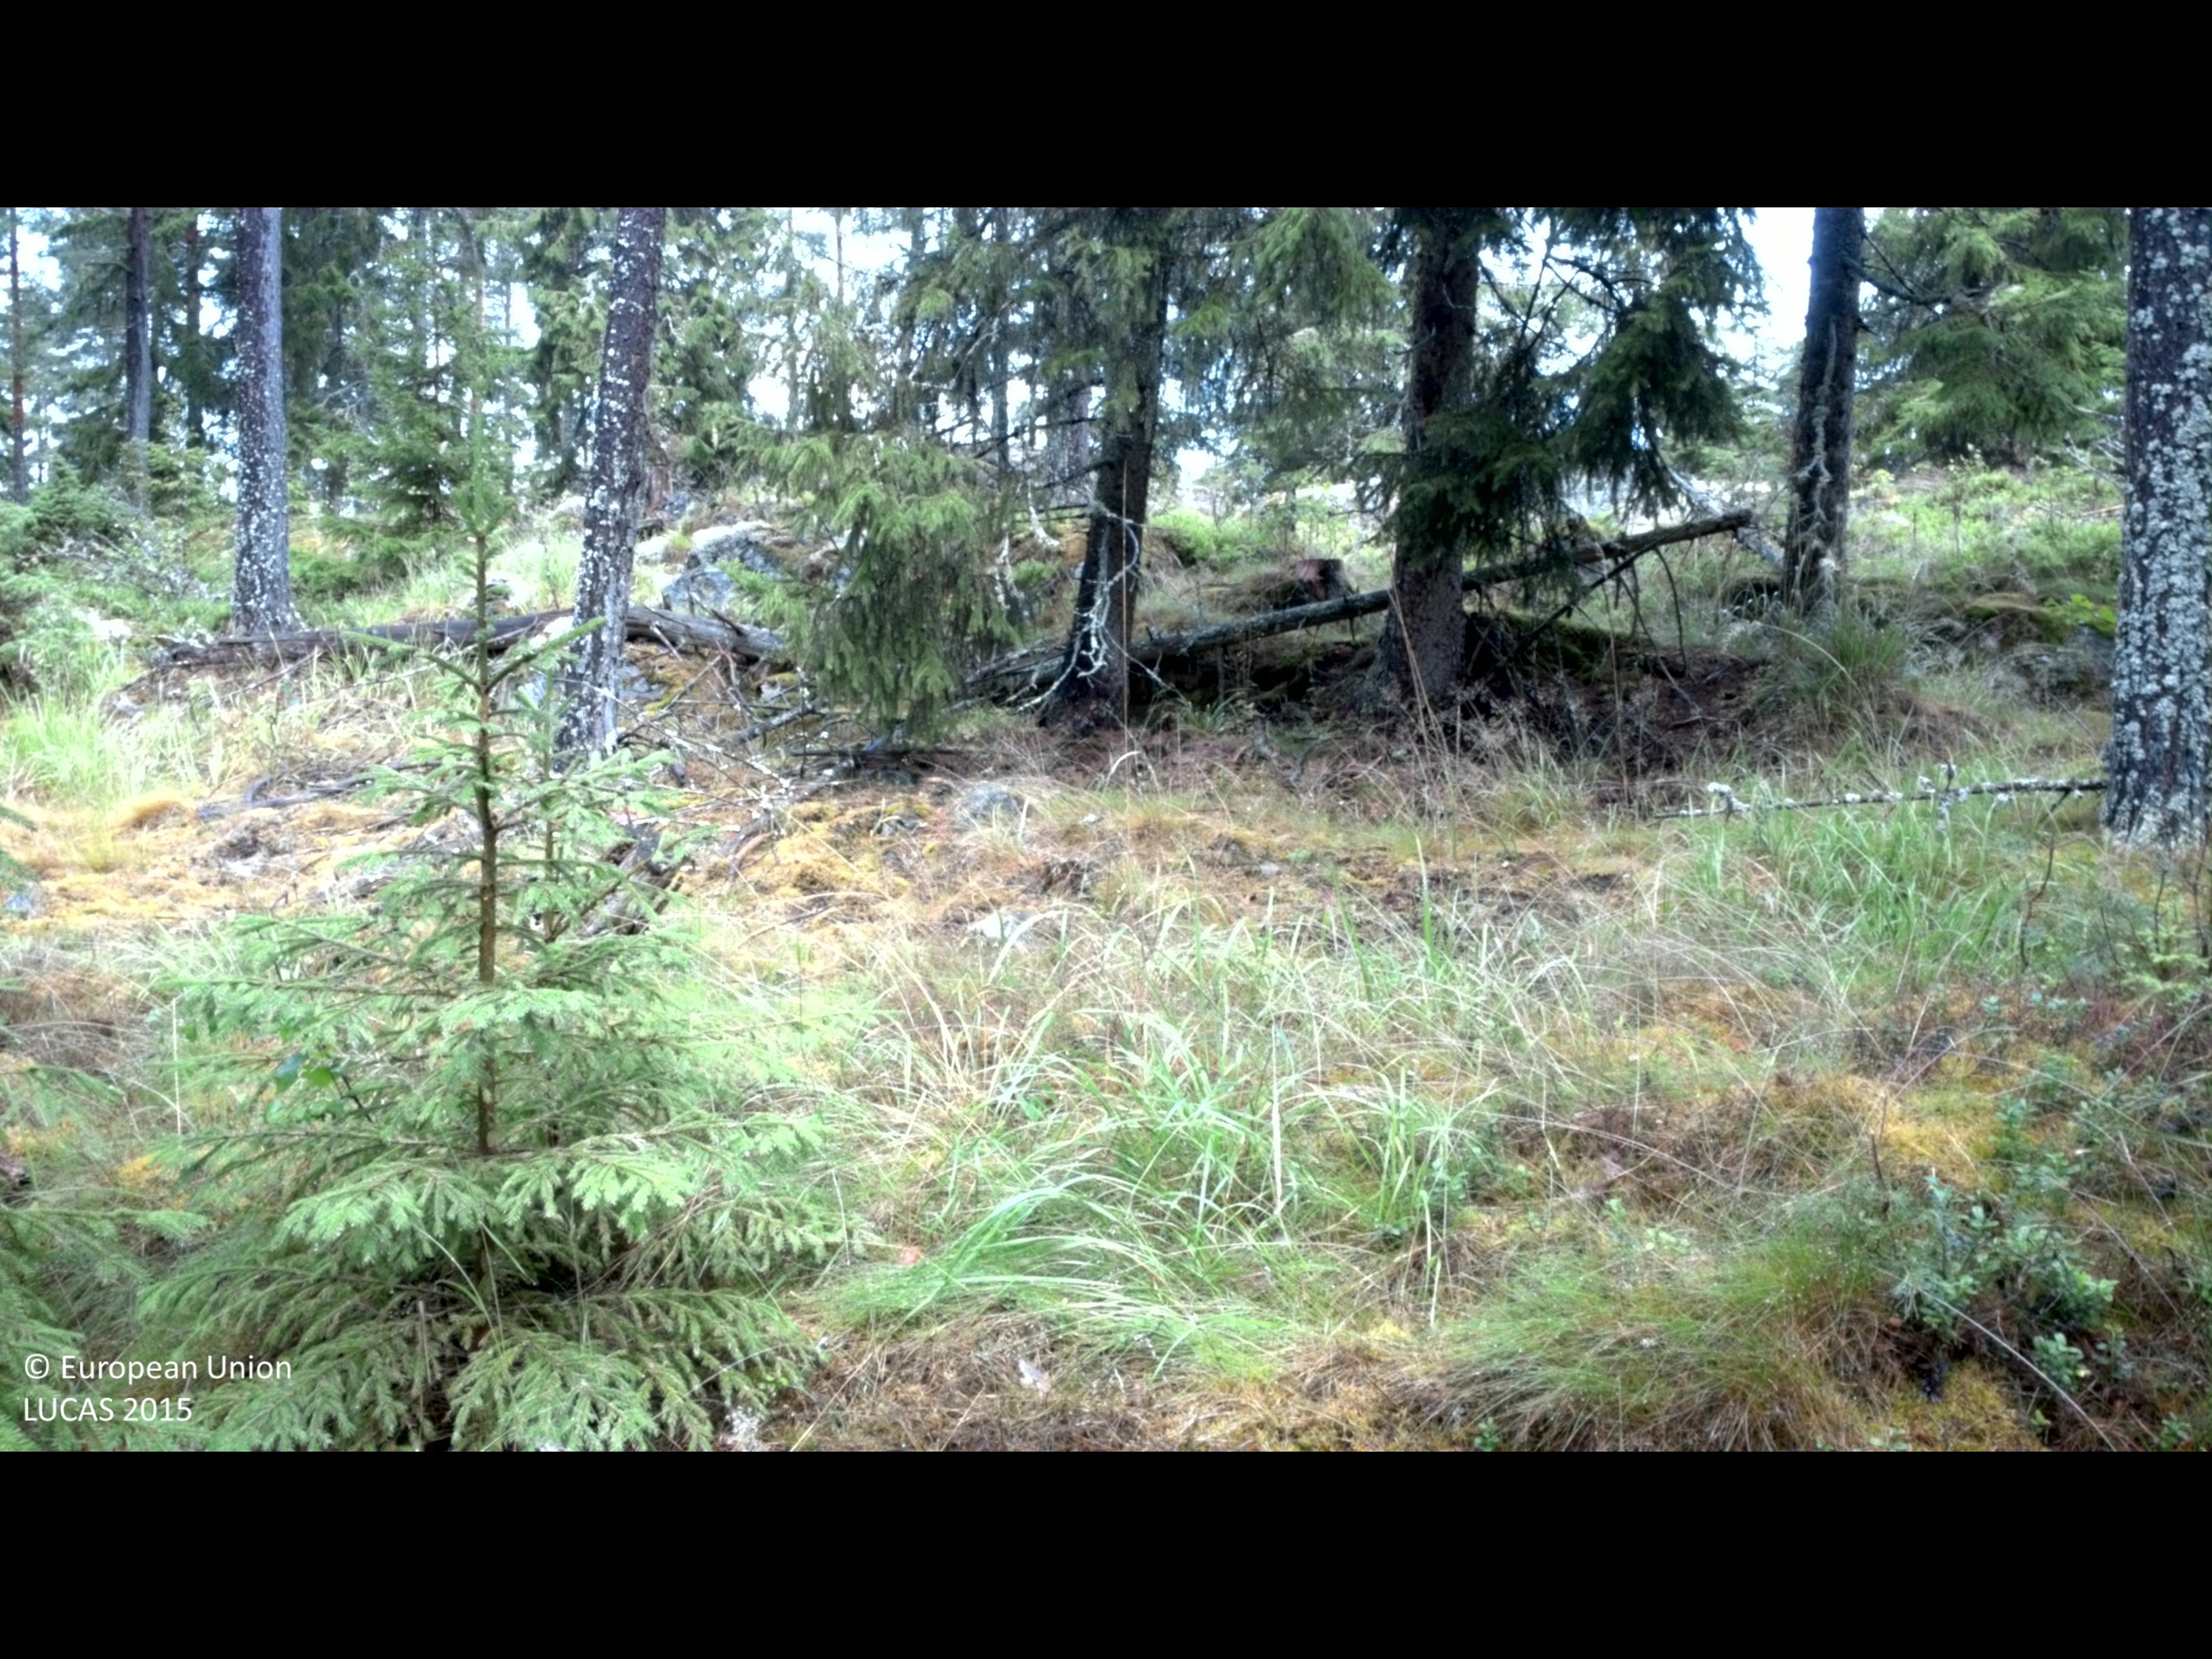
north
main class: Woodland
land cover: Pine dominated coniferous woodland
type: boreal forest
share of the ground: 50 - 75 %
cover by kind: coniferous forest trees 55 %, shrubs 30 %, lichens and mosses 10 %, herbaceous plants 5 %
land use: Forestry
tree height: > 5 m
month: July
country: SE
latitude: 58.3652
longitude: 16.2008
